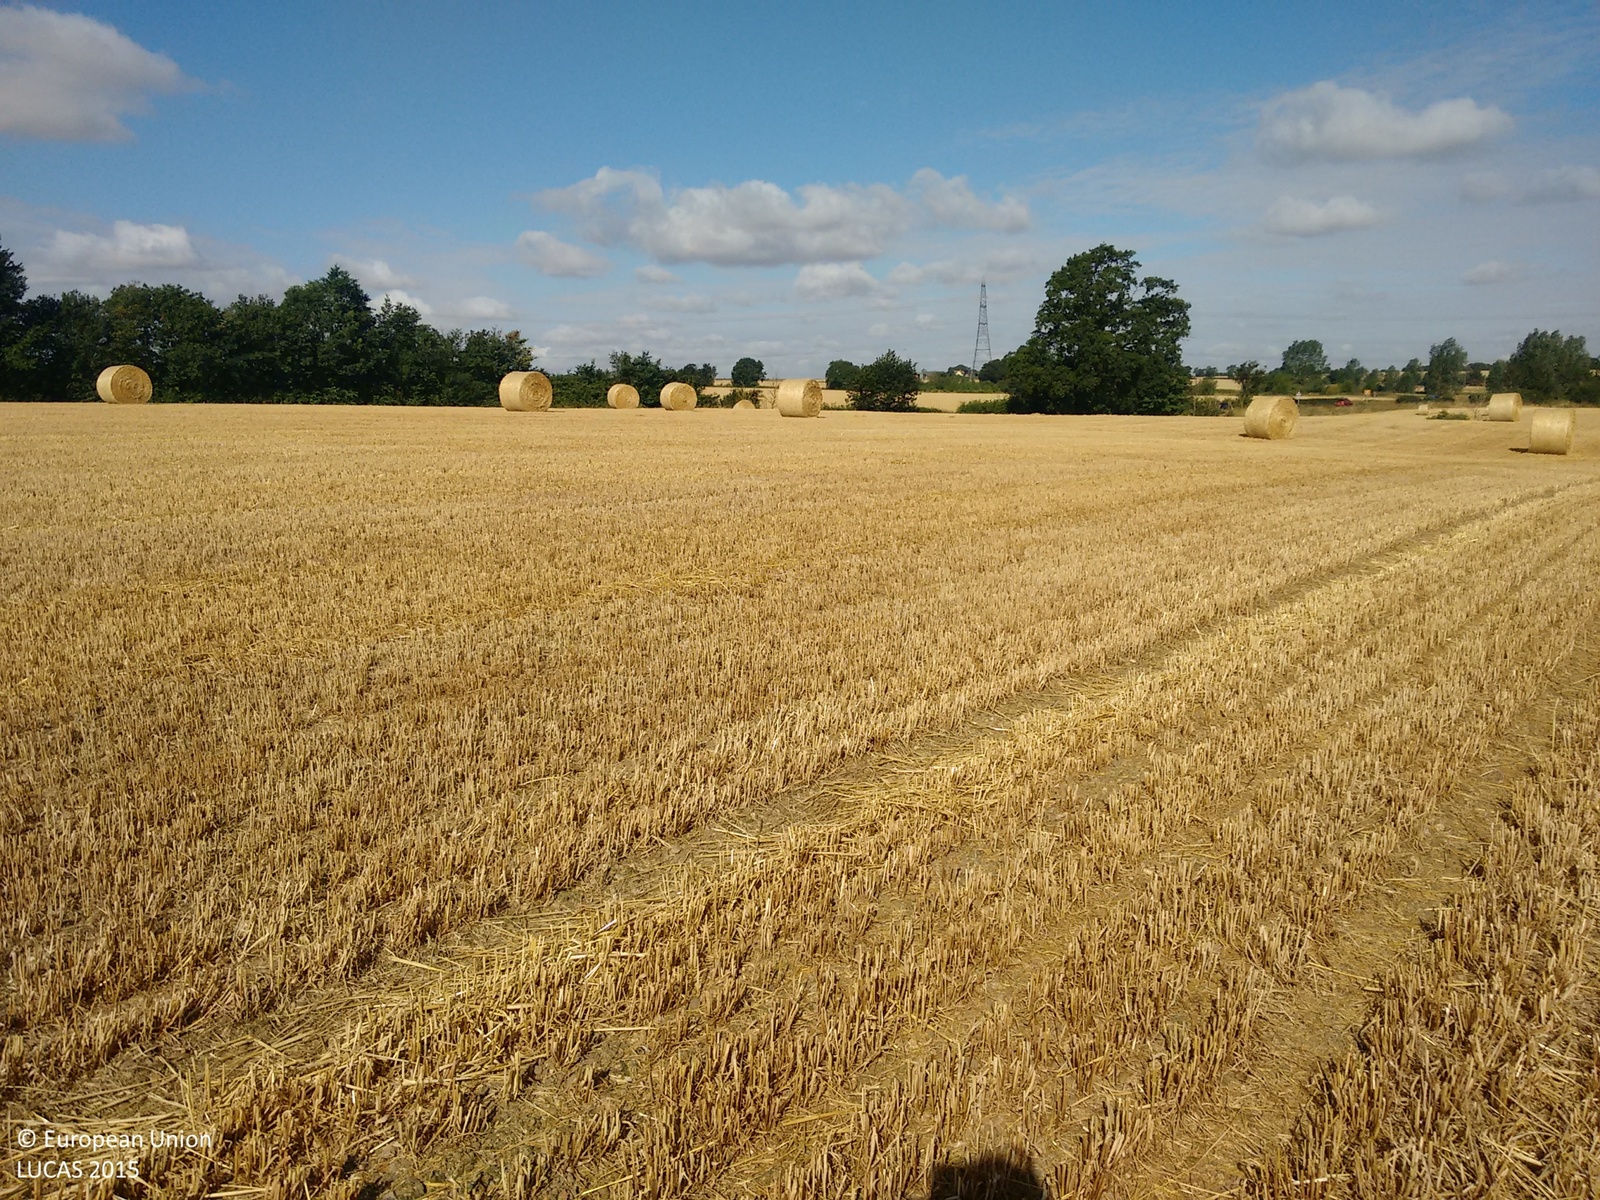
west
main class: Cropland
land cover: Barley
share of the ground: > 75 %
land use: Agriculture (excluding fallow land and kitchen gardens)
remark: Harvested field
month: July
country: GB
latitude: 51.8394
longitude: 0.5825
